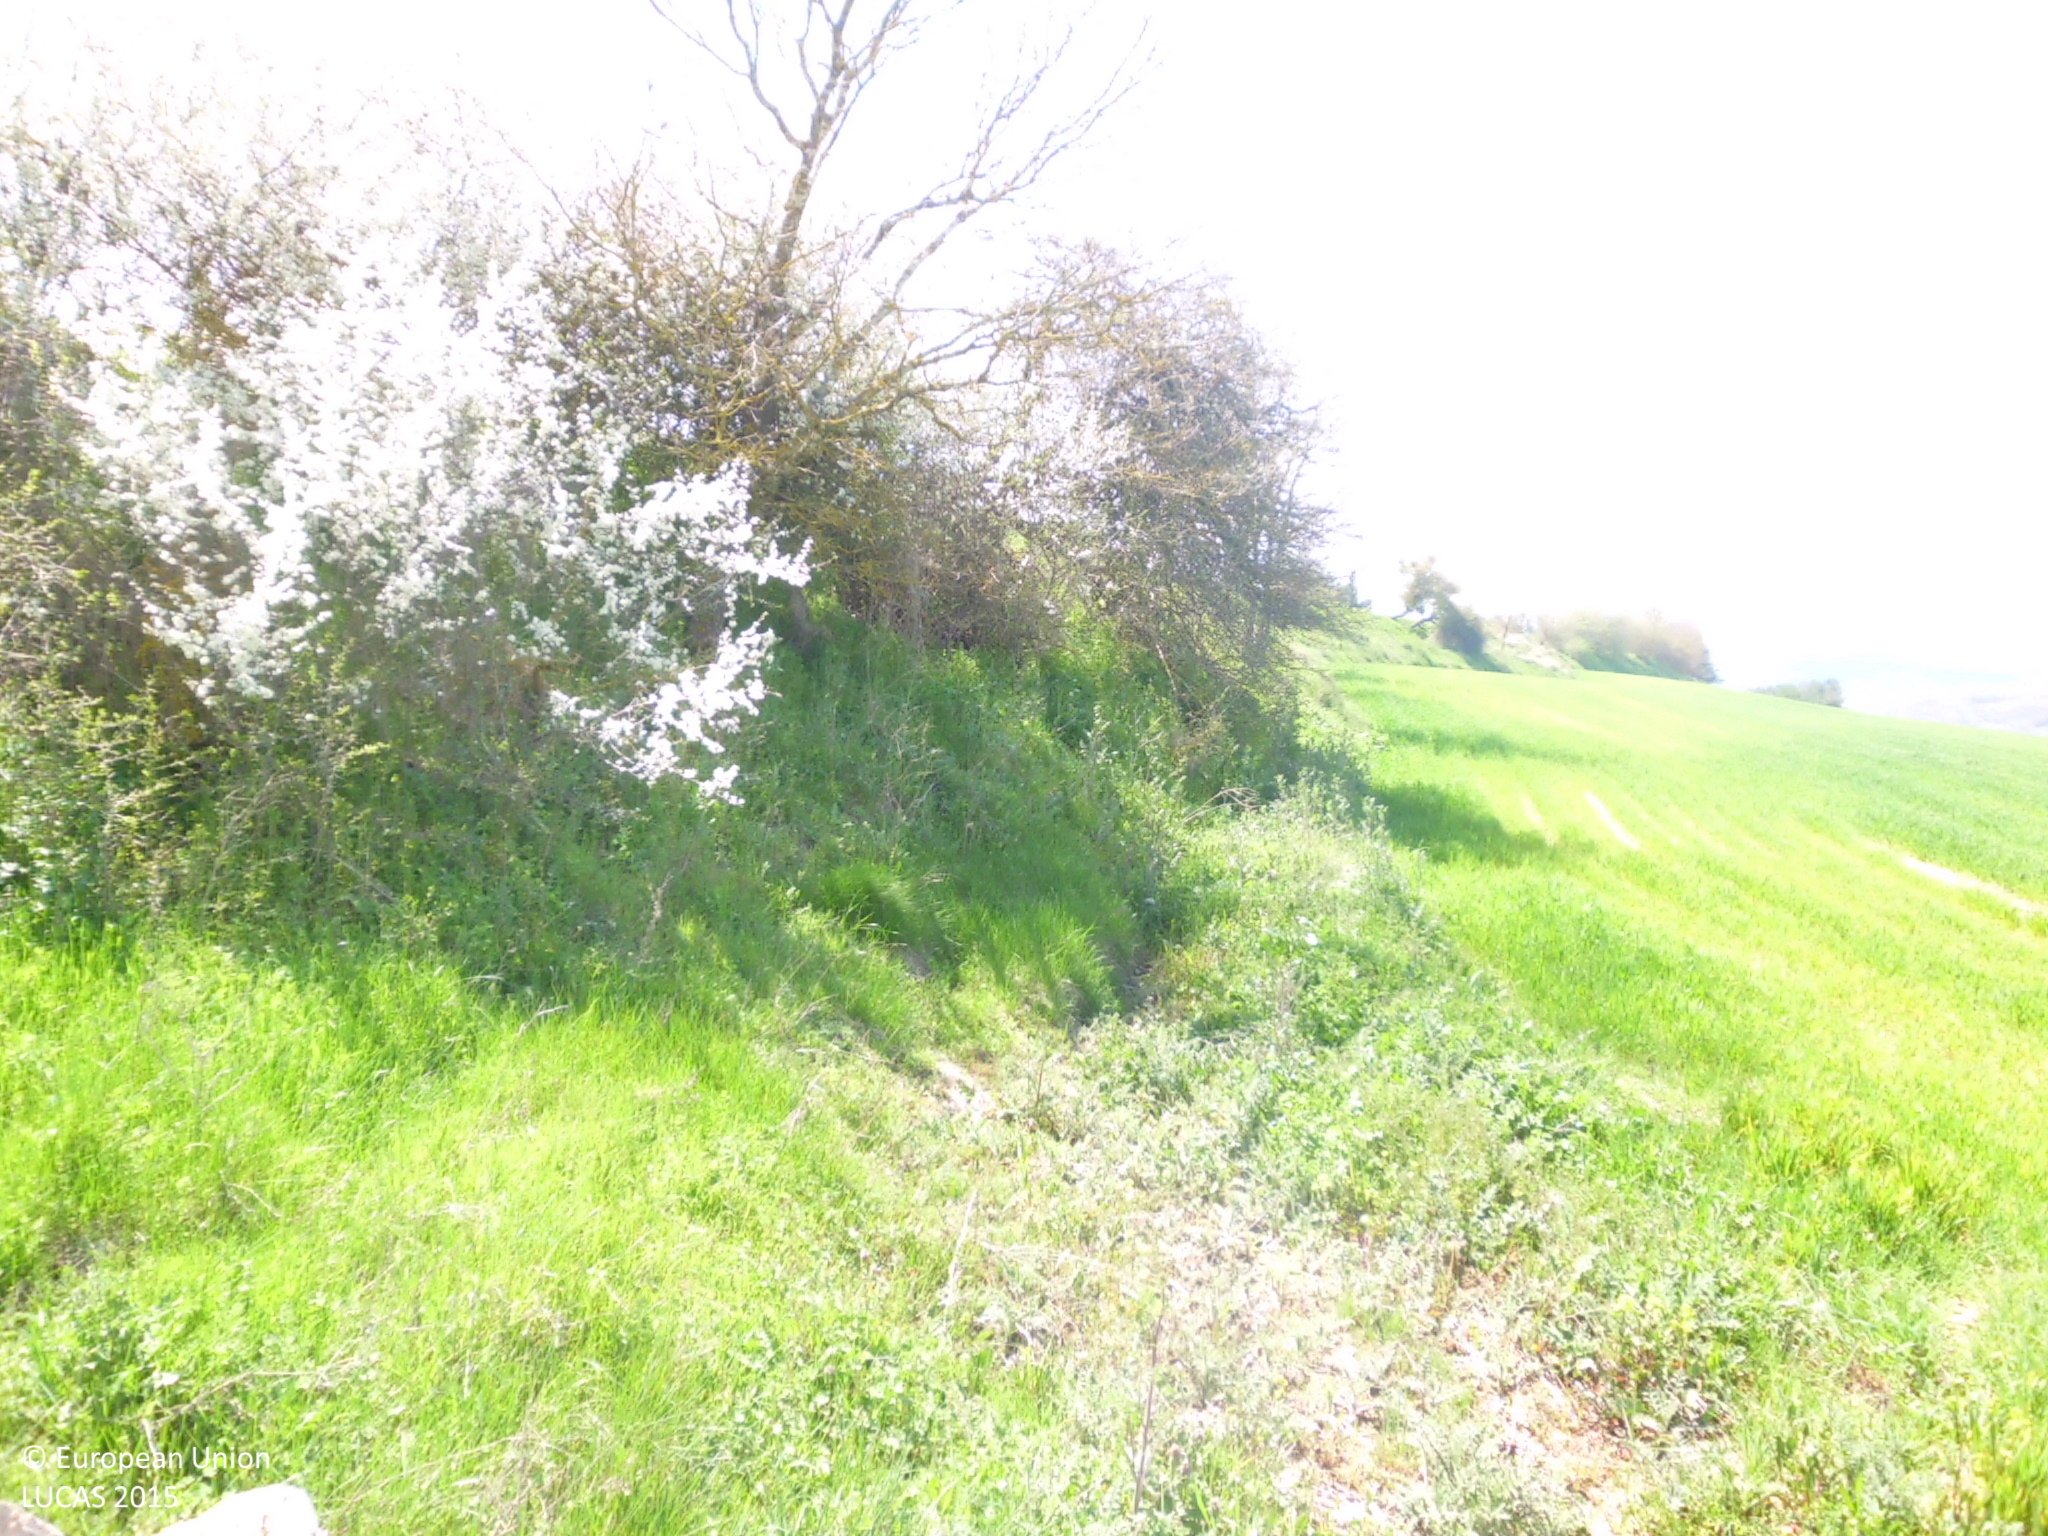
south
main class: Grassland
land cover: Grassland with sparse tree/shrub cover
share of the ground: > 75 %
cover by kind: herbaceous plants 90 %, broadleaved forest trees 5 %, shrubs 5 %
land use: Abandoned areas
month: April
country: ES
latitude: 42.4639
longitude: -3.3245
